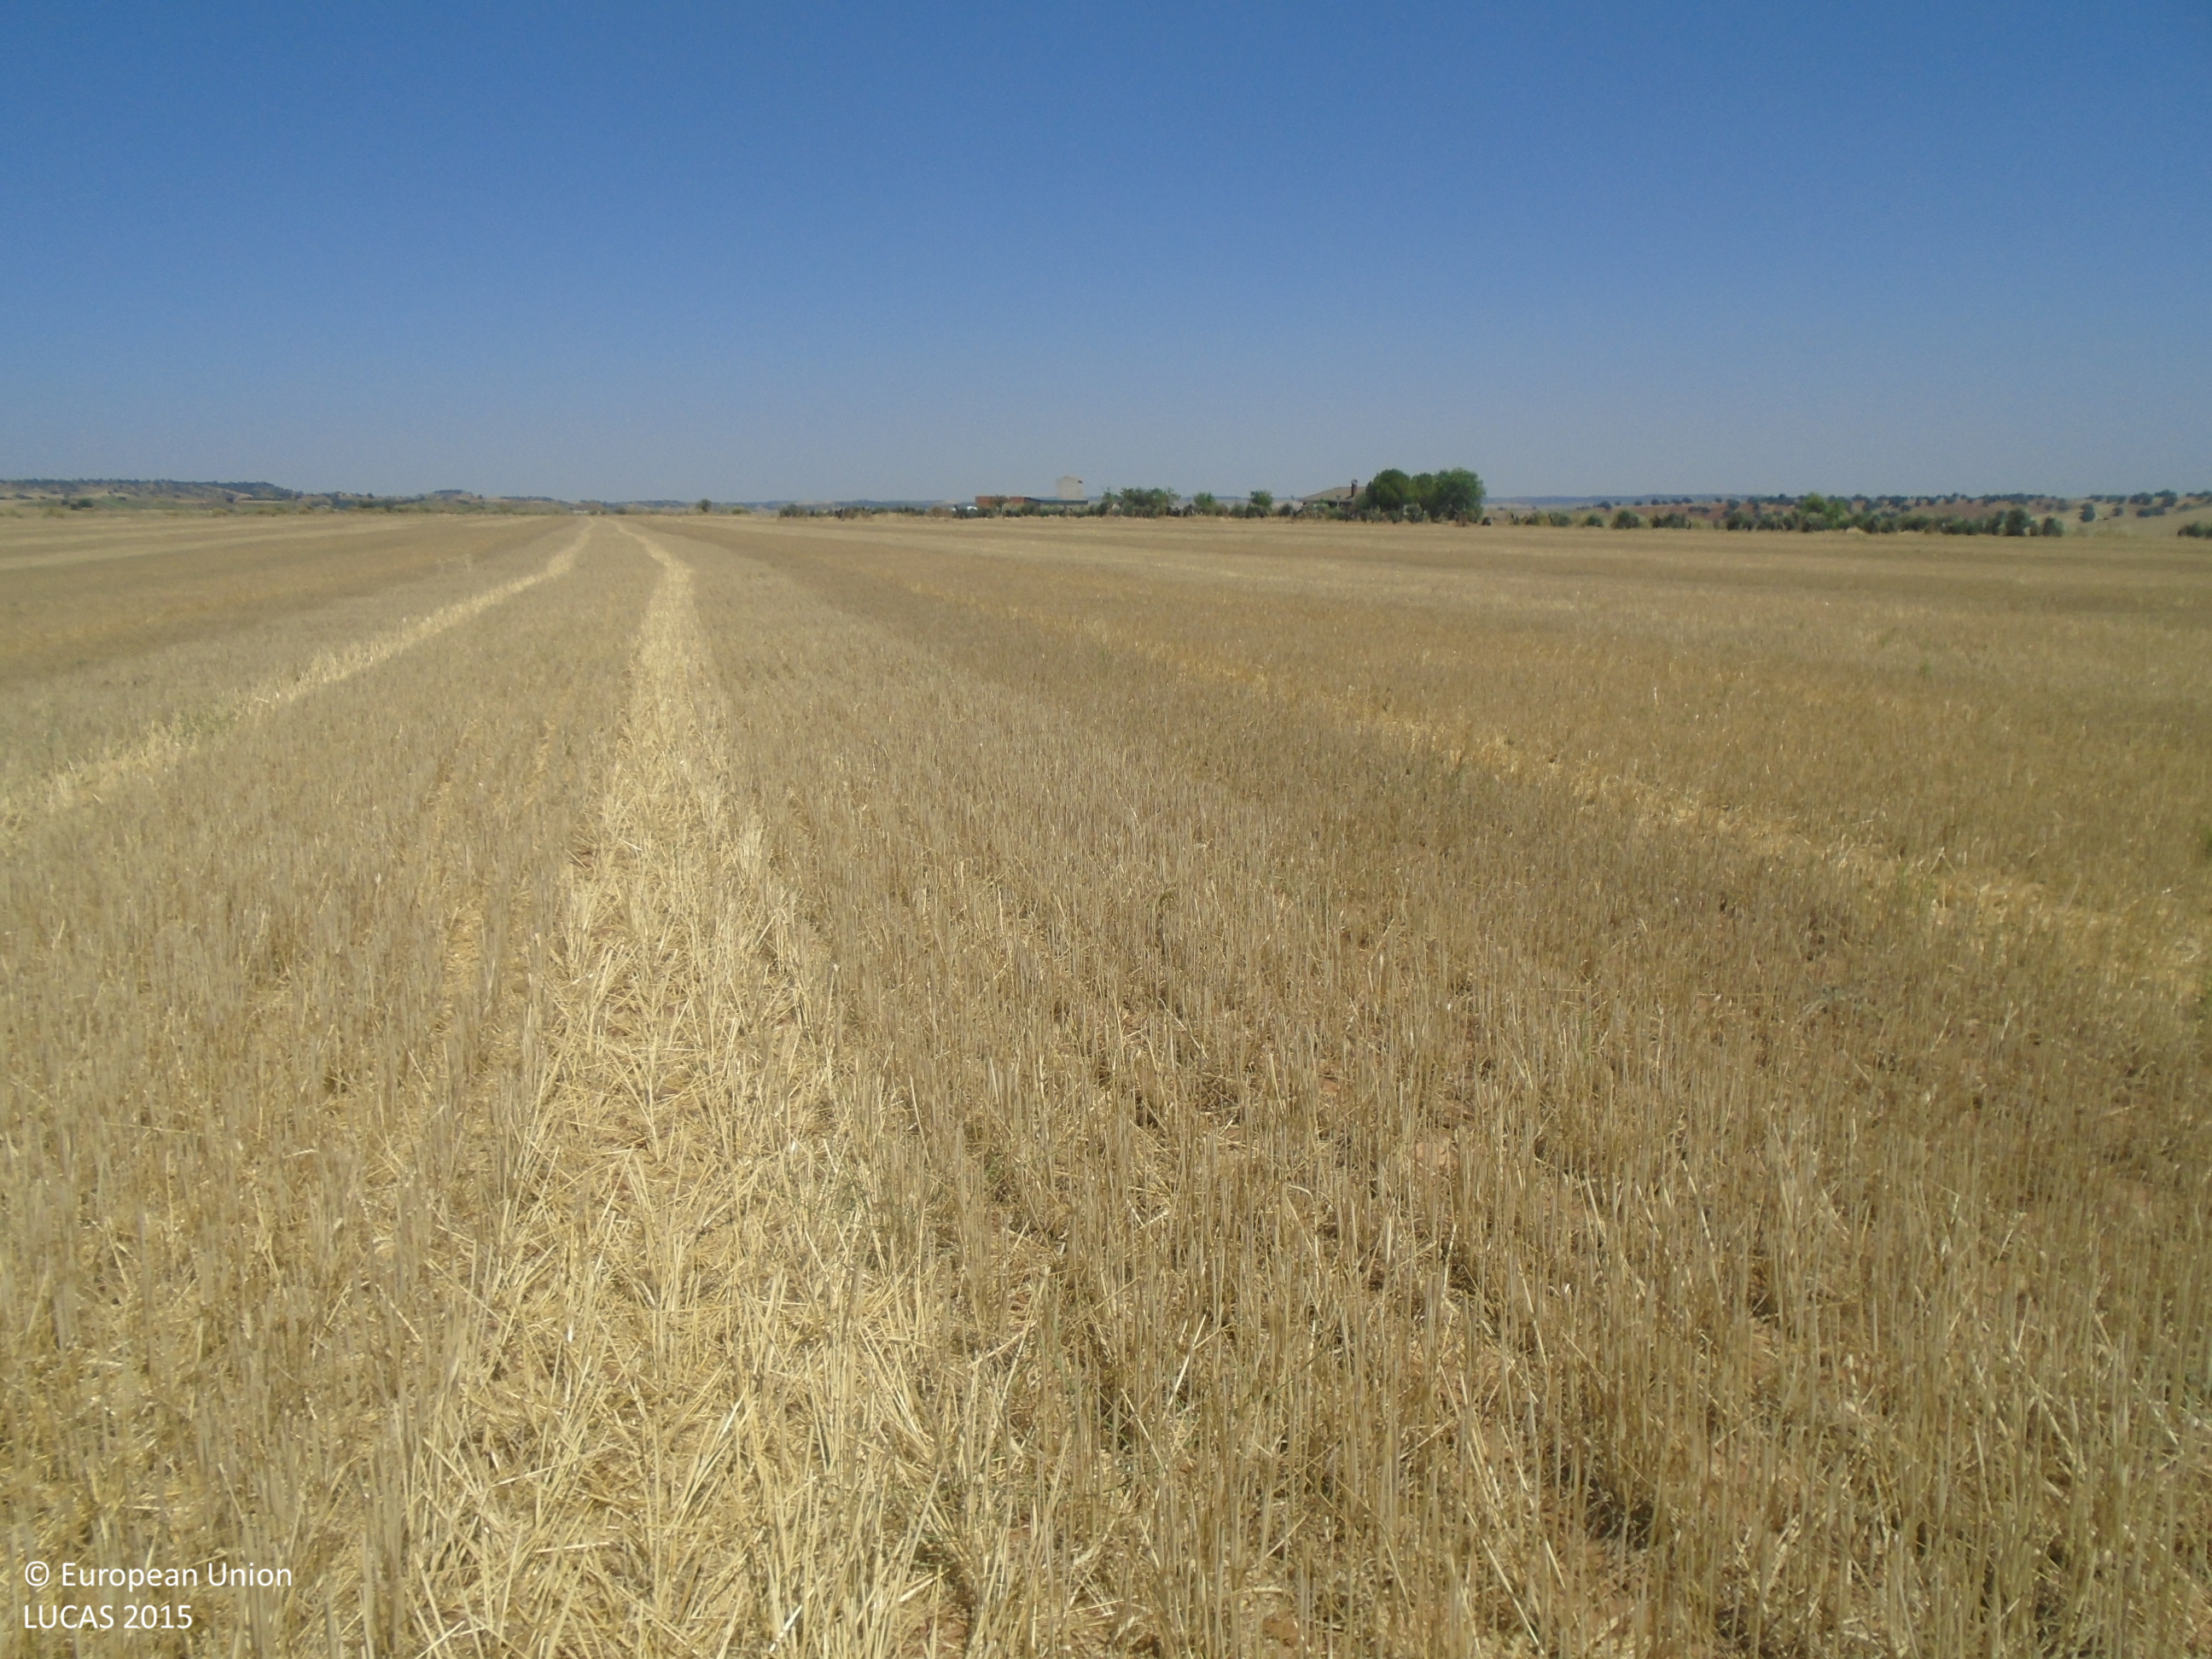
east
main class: Cropland
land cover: Common wheat
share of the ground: > 75 %
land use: Agriculture (excluding fallow land and kitchen gardens)
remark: Harvested field
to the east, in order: Common wheat; Grass margins; Olive groves; Grassland with sparse tree/shrub cover
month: July
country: ES
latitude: 39.8103
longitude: -4.9644
